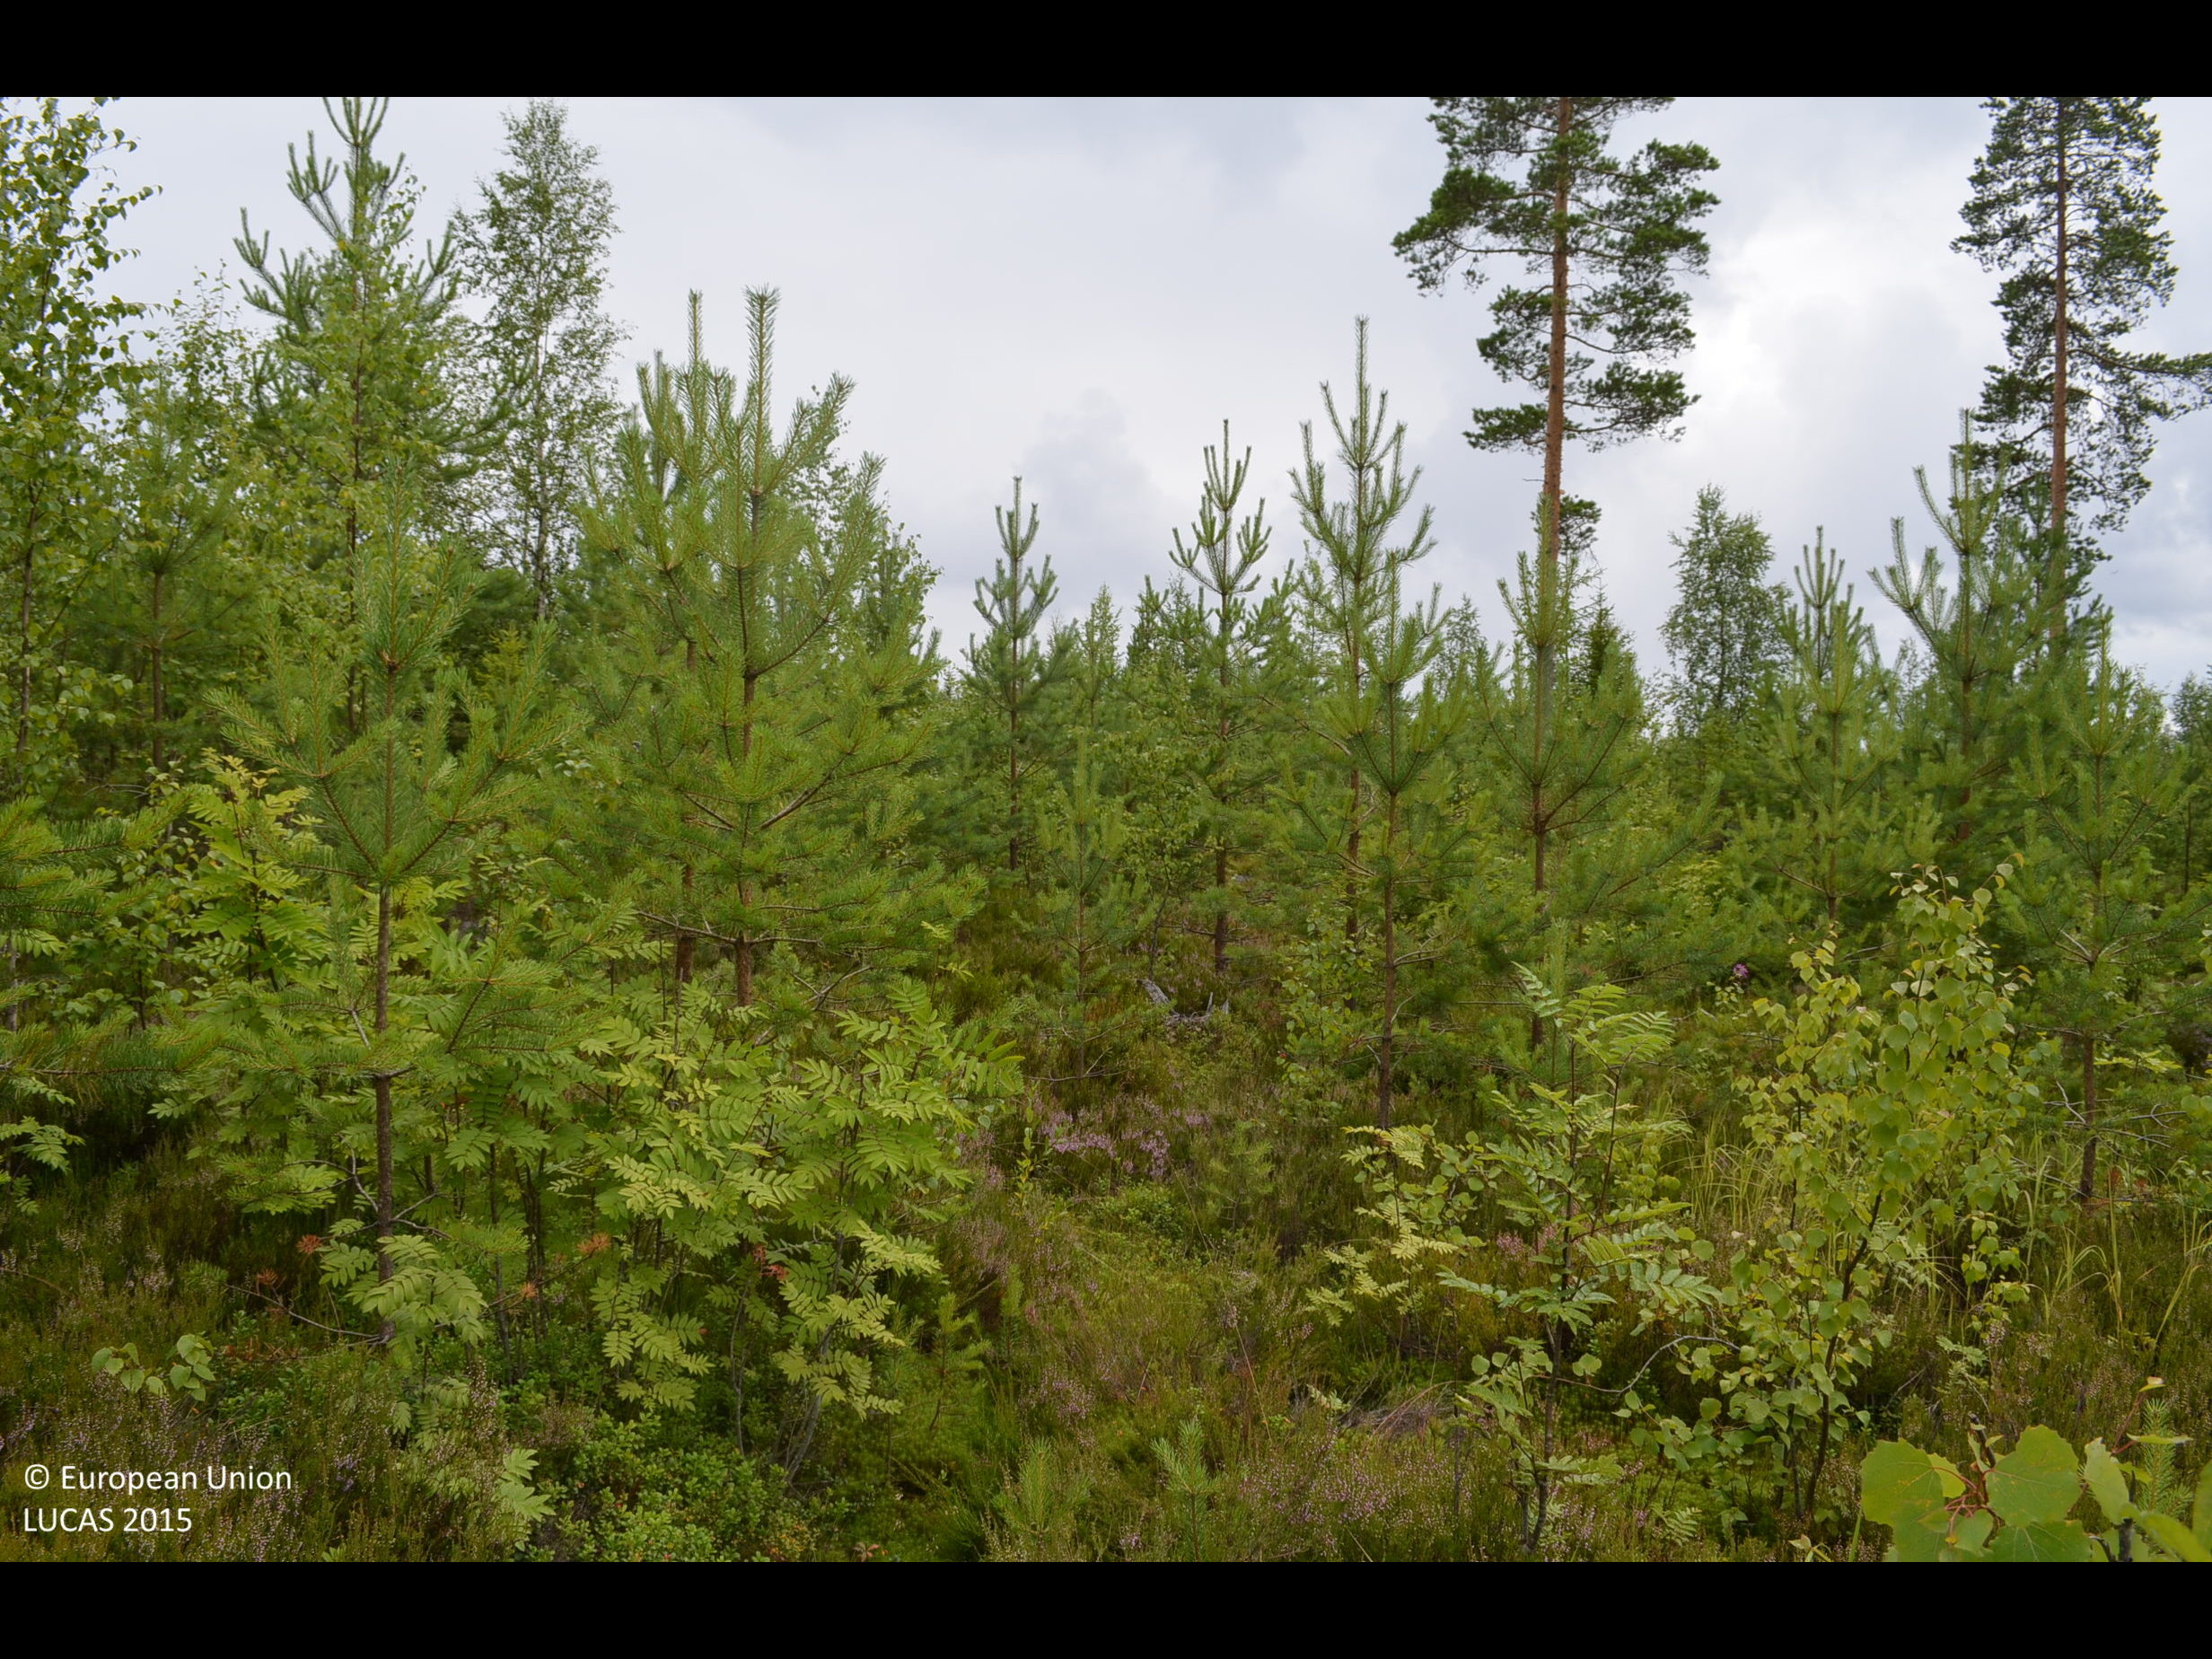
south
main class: Woodland
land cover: Pine dominated mixed woodland
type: boreal forest
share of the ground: 50 - 75 %
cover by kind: coniferous forest trees 35 %, shrubs 35 %, broadleaved forest trees 25 %, herbaceous plants 5 %
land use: Forestry
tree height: < 5 m
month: July
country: FI
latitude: 61.9339
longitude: 24.2069
